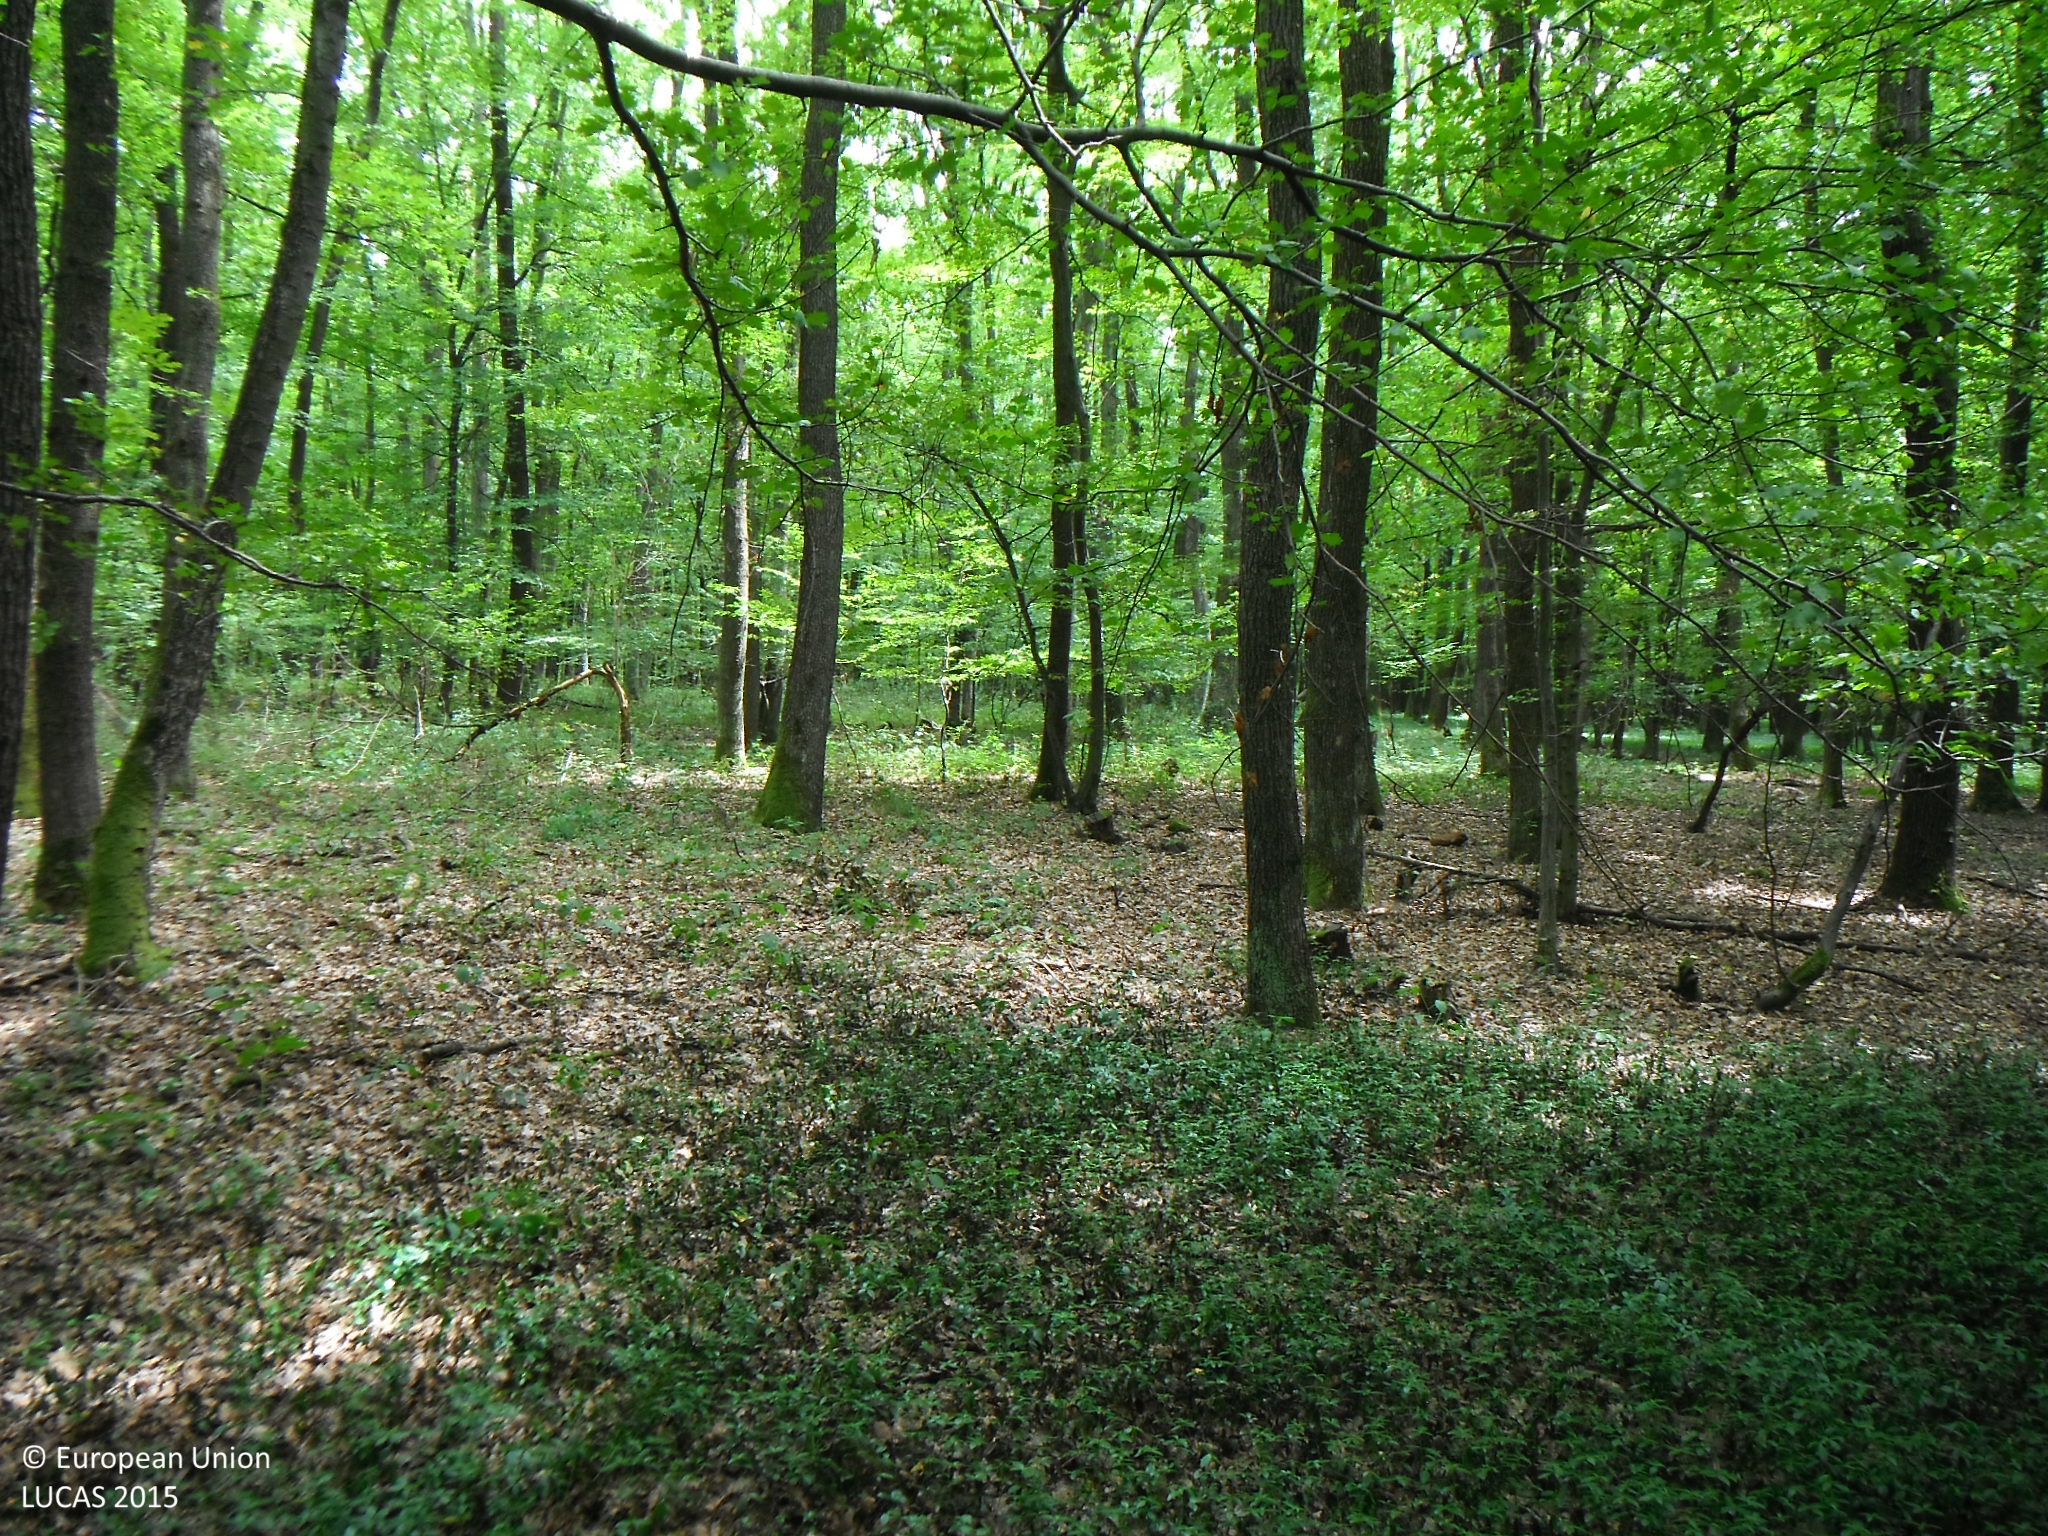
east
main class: Woodland
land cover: Broadleaved woodland
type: acidophilous oak and oak-birch forest
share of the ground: > 75 %
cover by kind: broadleaved forest trees 100 %
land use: Forestry
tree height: > 5 m
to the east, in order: Broadleaved woodland; Tracks; Broadleaved woodland
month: July
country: SK
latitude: 48.6934
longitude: 21.3075
